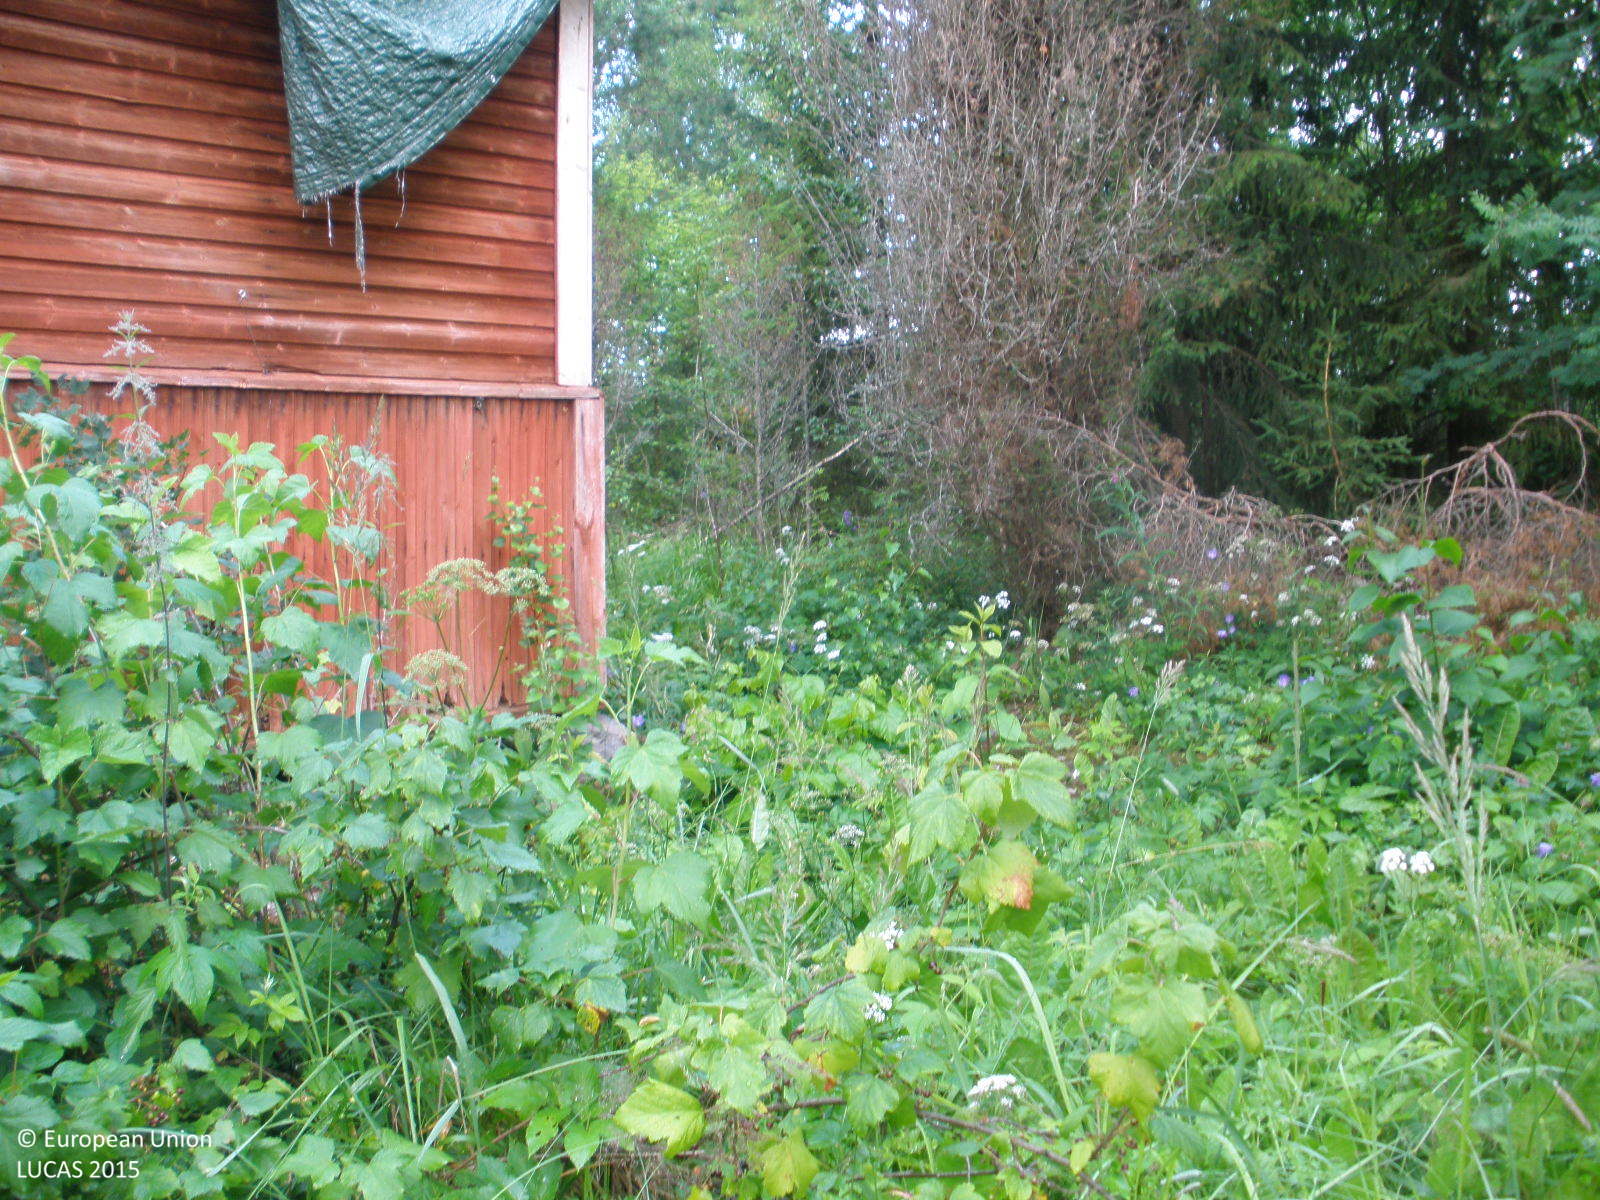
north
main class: Cropland
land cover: Other fruit trees and berries
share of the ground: > 75 %
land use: Kitchen garden
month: July
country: FI
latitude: 61.5101
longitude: 24.5896
